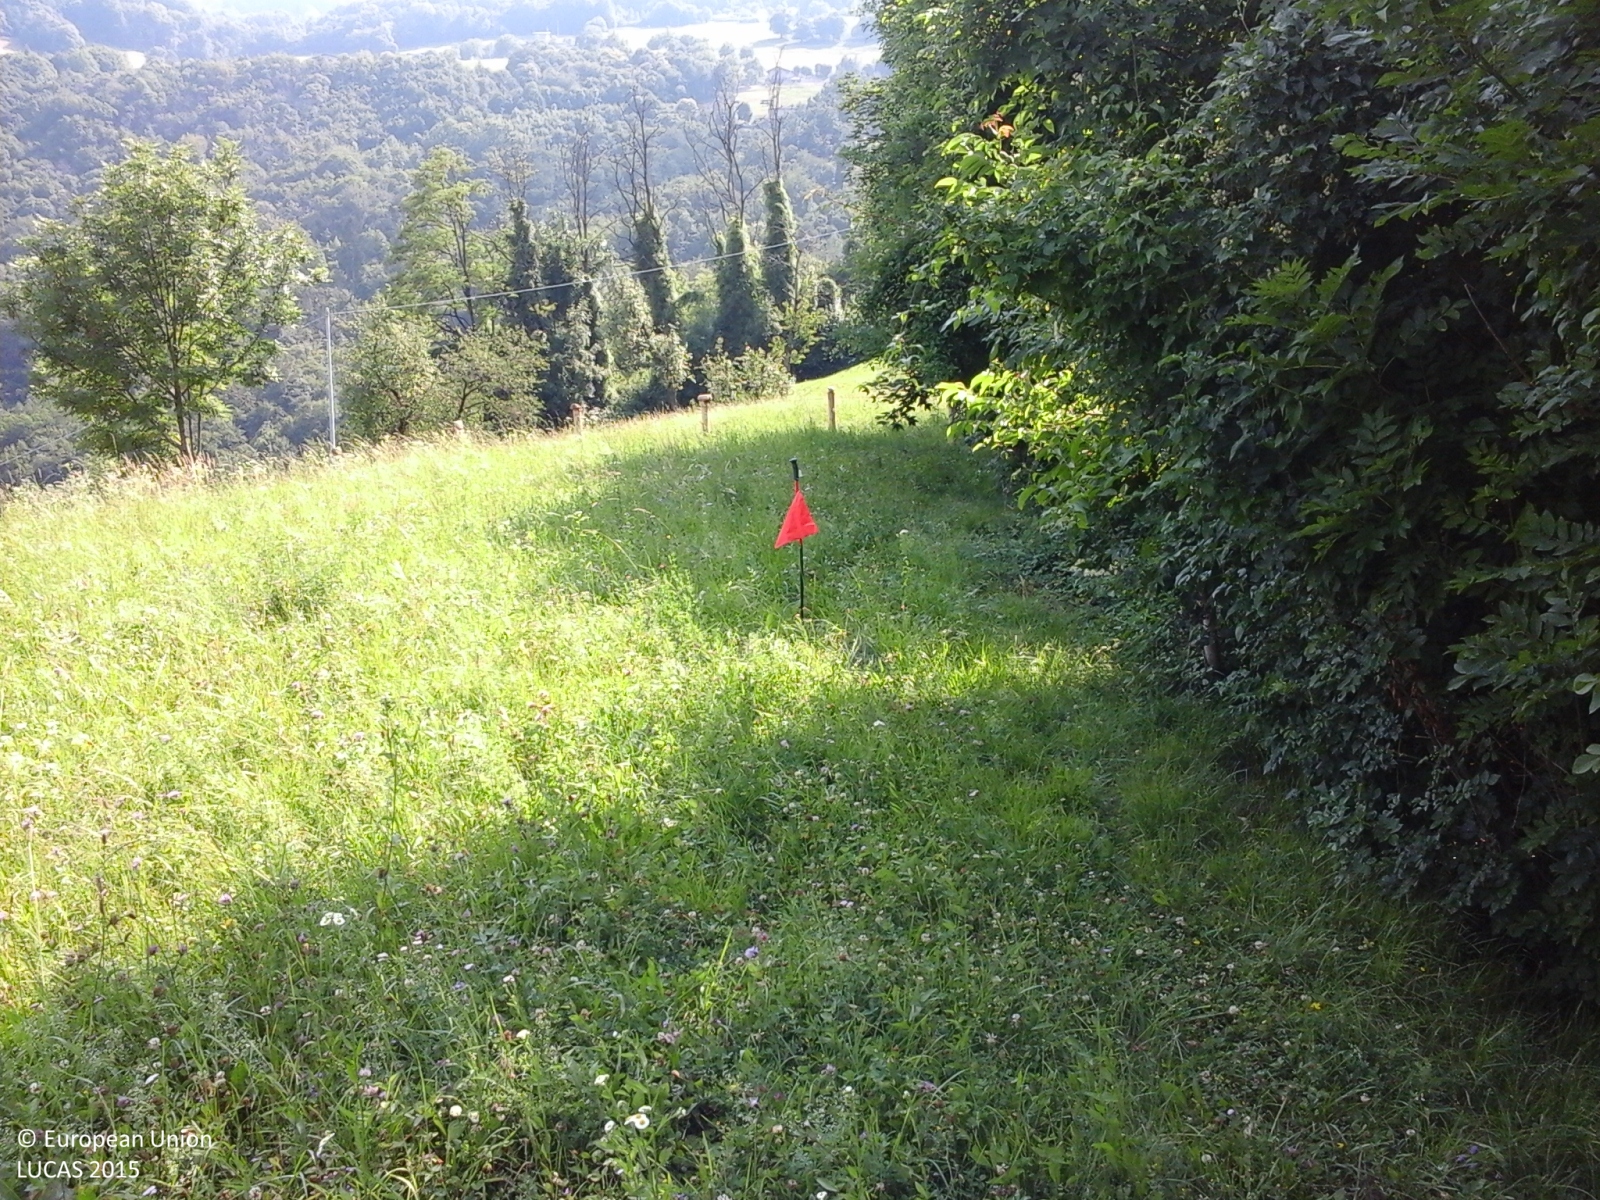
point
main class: Grassland
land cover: Grassland without tree/shrub cover
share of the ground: > 75 %
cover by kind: herbaceous plants 100 %
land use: Agriculture (excluding fallow land and kitchen gardens)
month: June
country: IT
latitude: 45.7566
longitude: 9.8845
